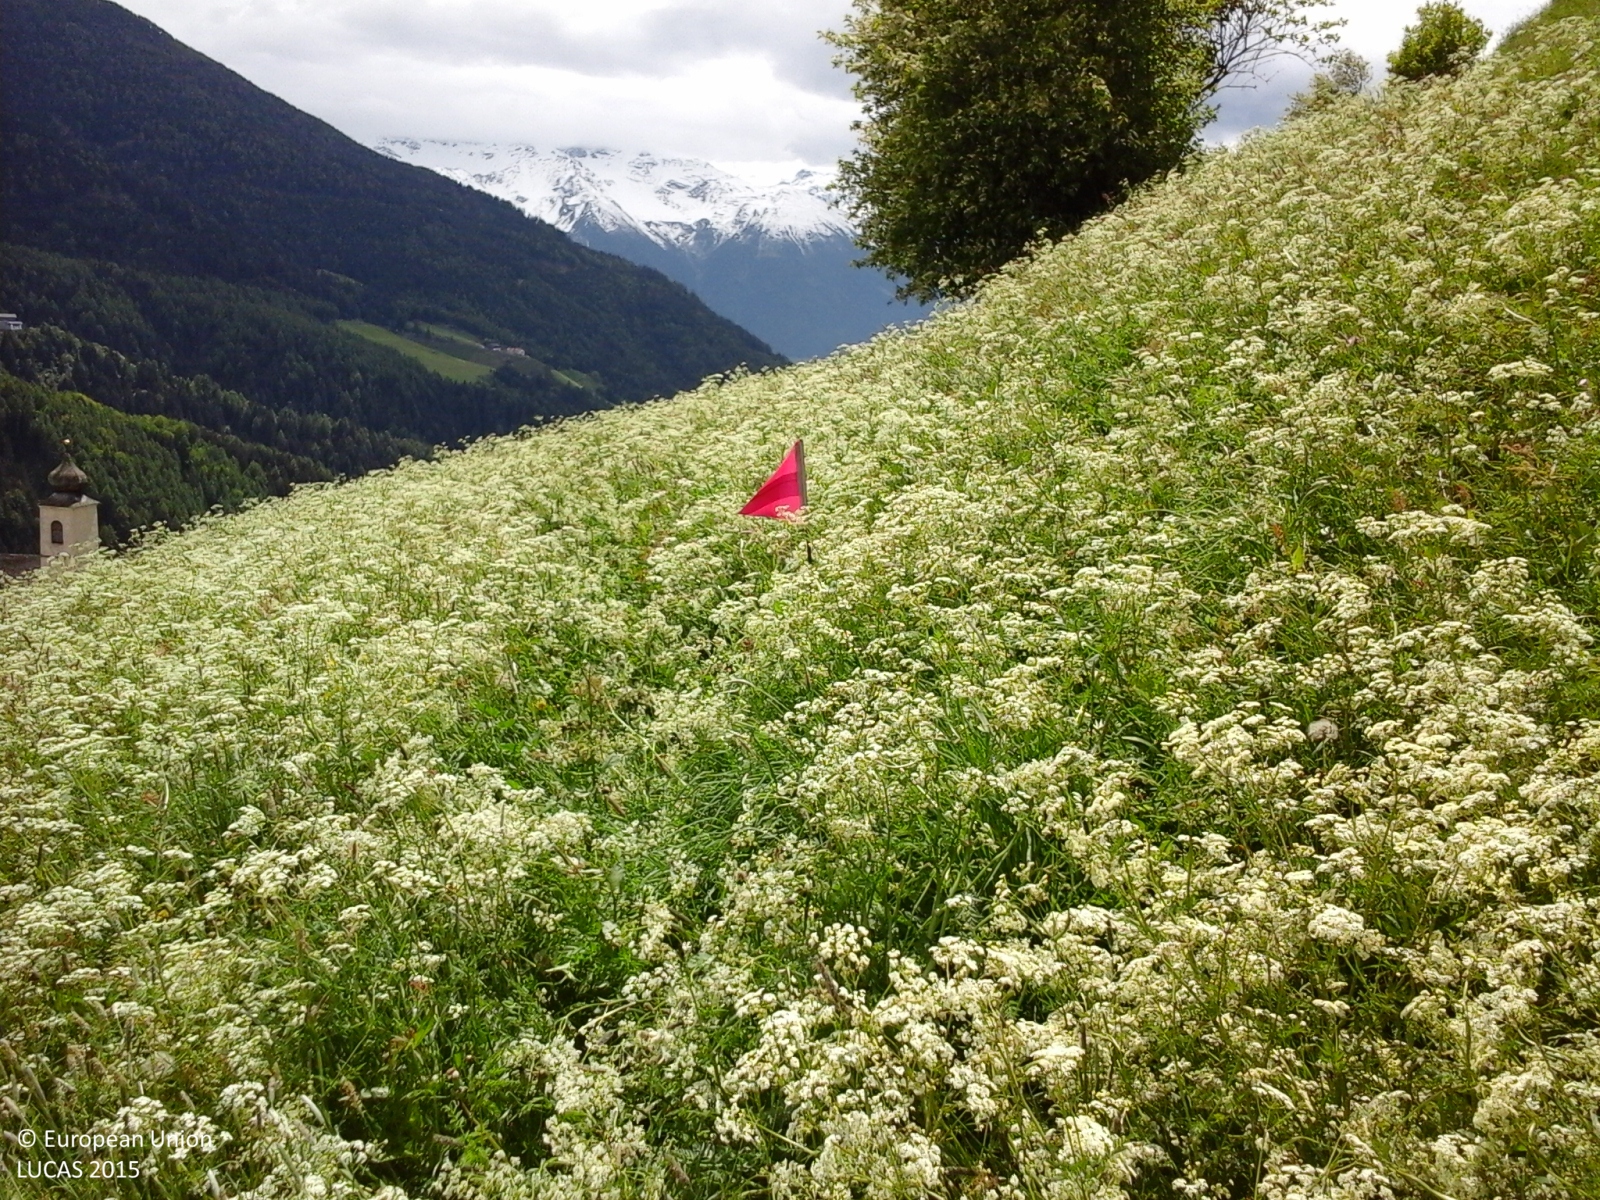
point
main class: Grassland
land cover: Grassland without tree/shrub cover
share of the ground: > 75 %
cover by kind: herbaceous plants 100 %
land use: Agriculture (excluding fallow land and kitchen gardens)
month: May
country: IT
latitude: 46.6917
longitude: 10.6138
